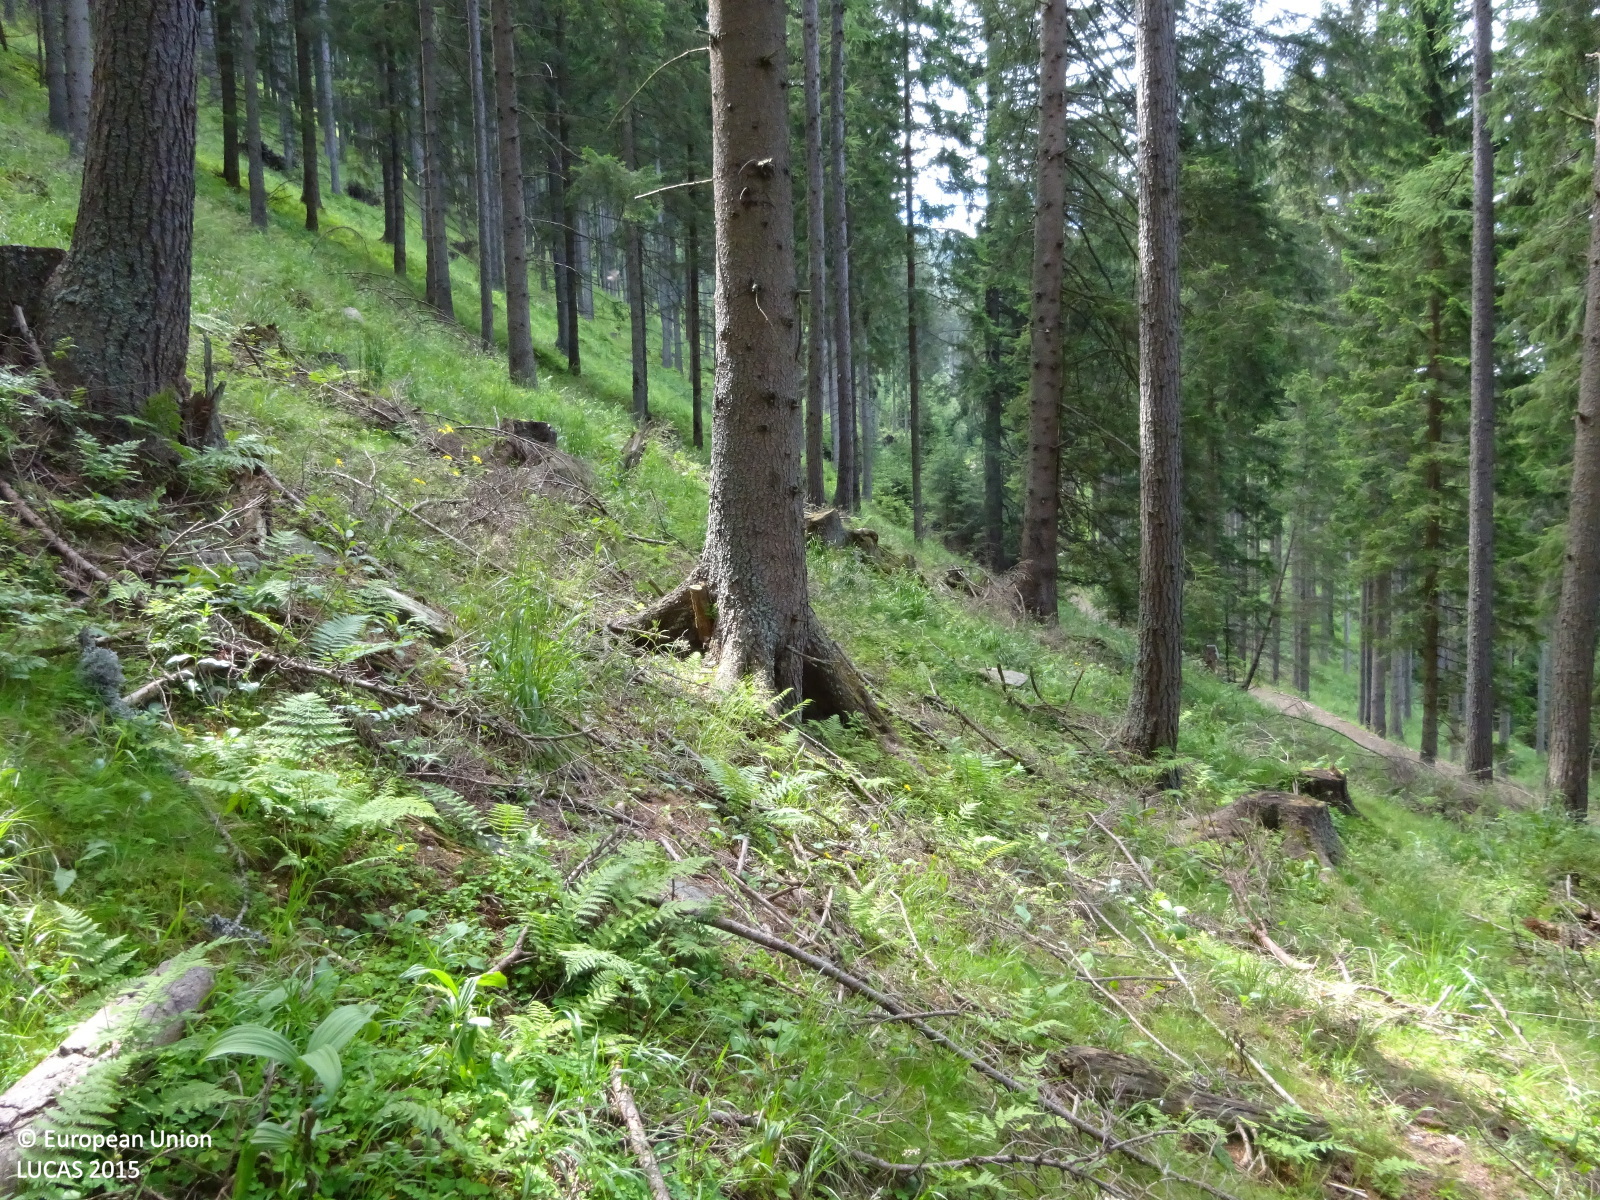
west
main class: Woodland
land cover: Spruce dominated coniferous woodland
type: alpine coniferous forest
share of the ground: > 75 %
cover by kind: coniferous forest trees 90 %, herbaceous plants 10 %
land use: Forestry
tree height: > 5 m
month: June
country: AT
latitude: 47.6010
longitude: 15.8143
